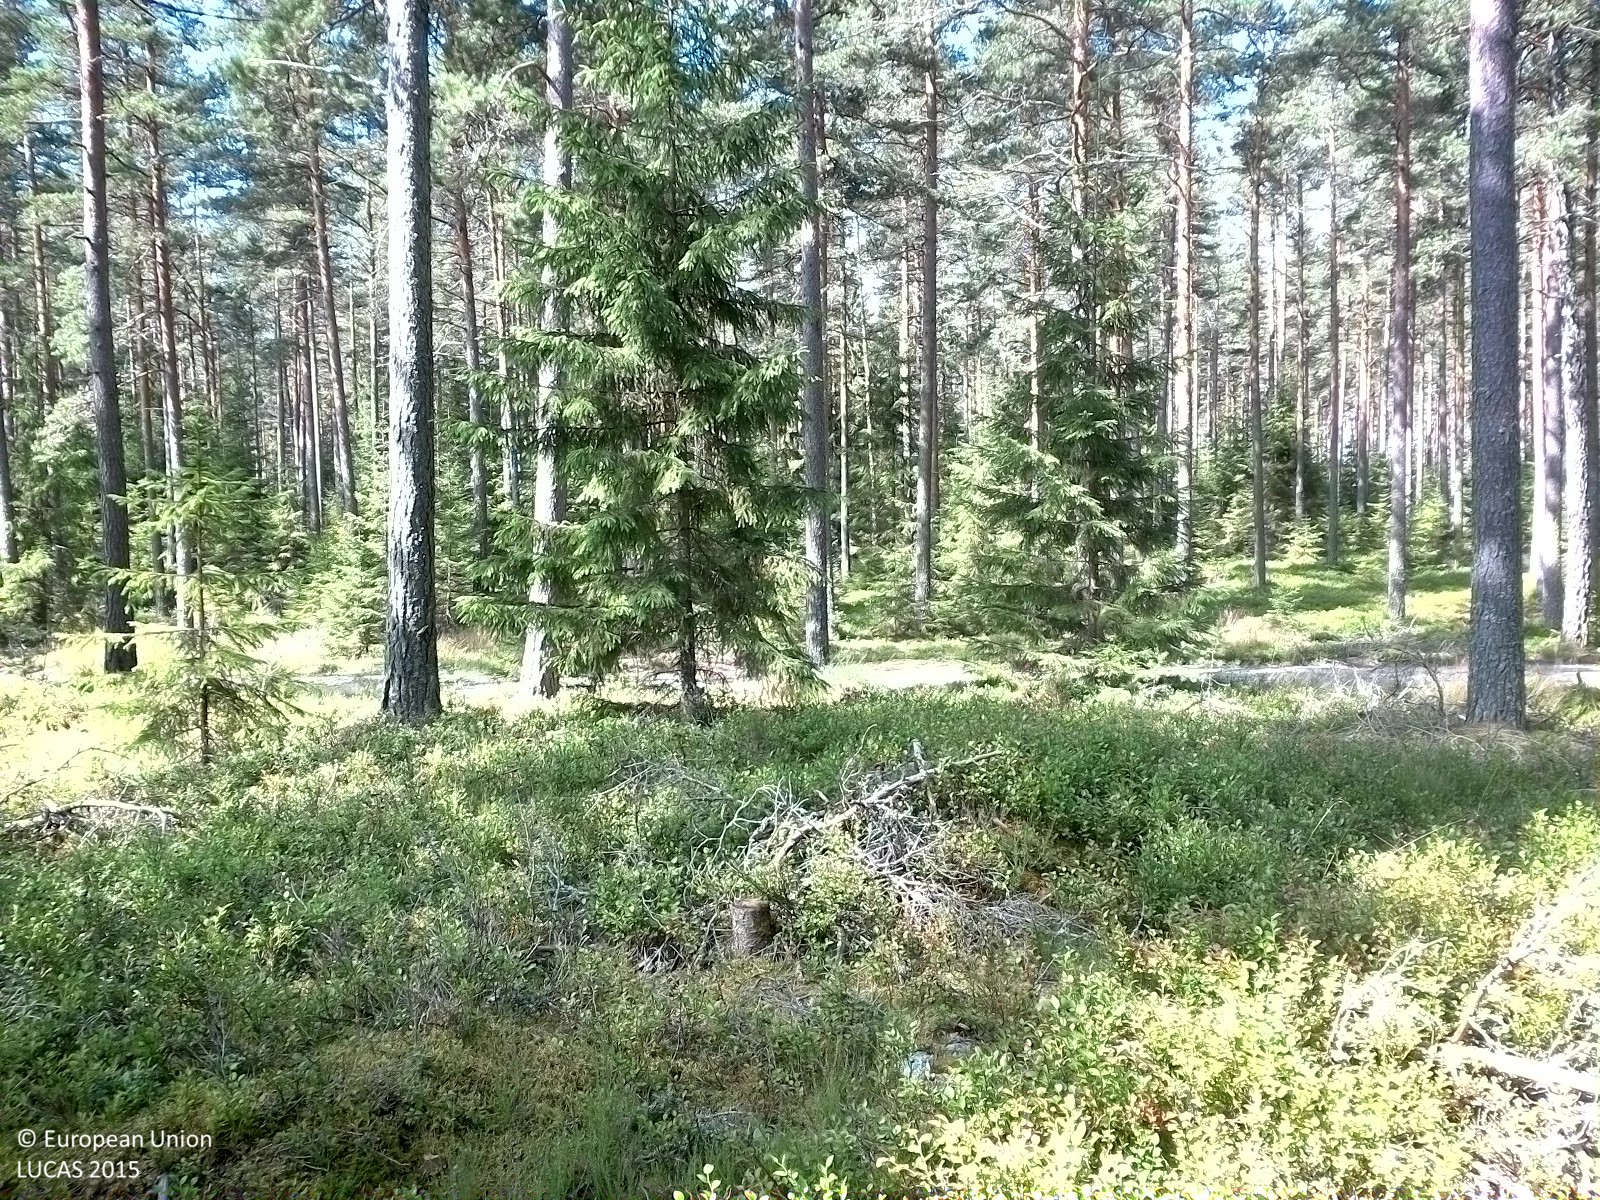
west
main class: Woodland
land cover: Pine dominated coniferous woodland
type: boreal forest
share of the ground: 25 - 50 %
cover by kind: herbaceous plants 40 %, coniferous forest trees 30 %, lichens and mosses 30 %
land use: Forestry
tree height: > 5 m
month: August
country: SE
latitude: 58.8856
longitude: 15.4235
